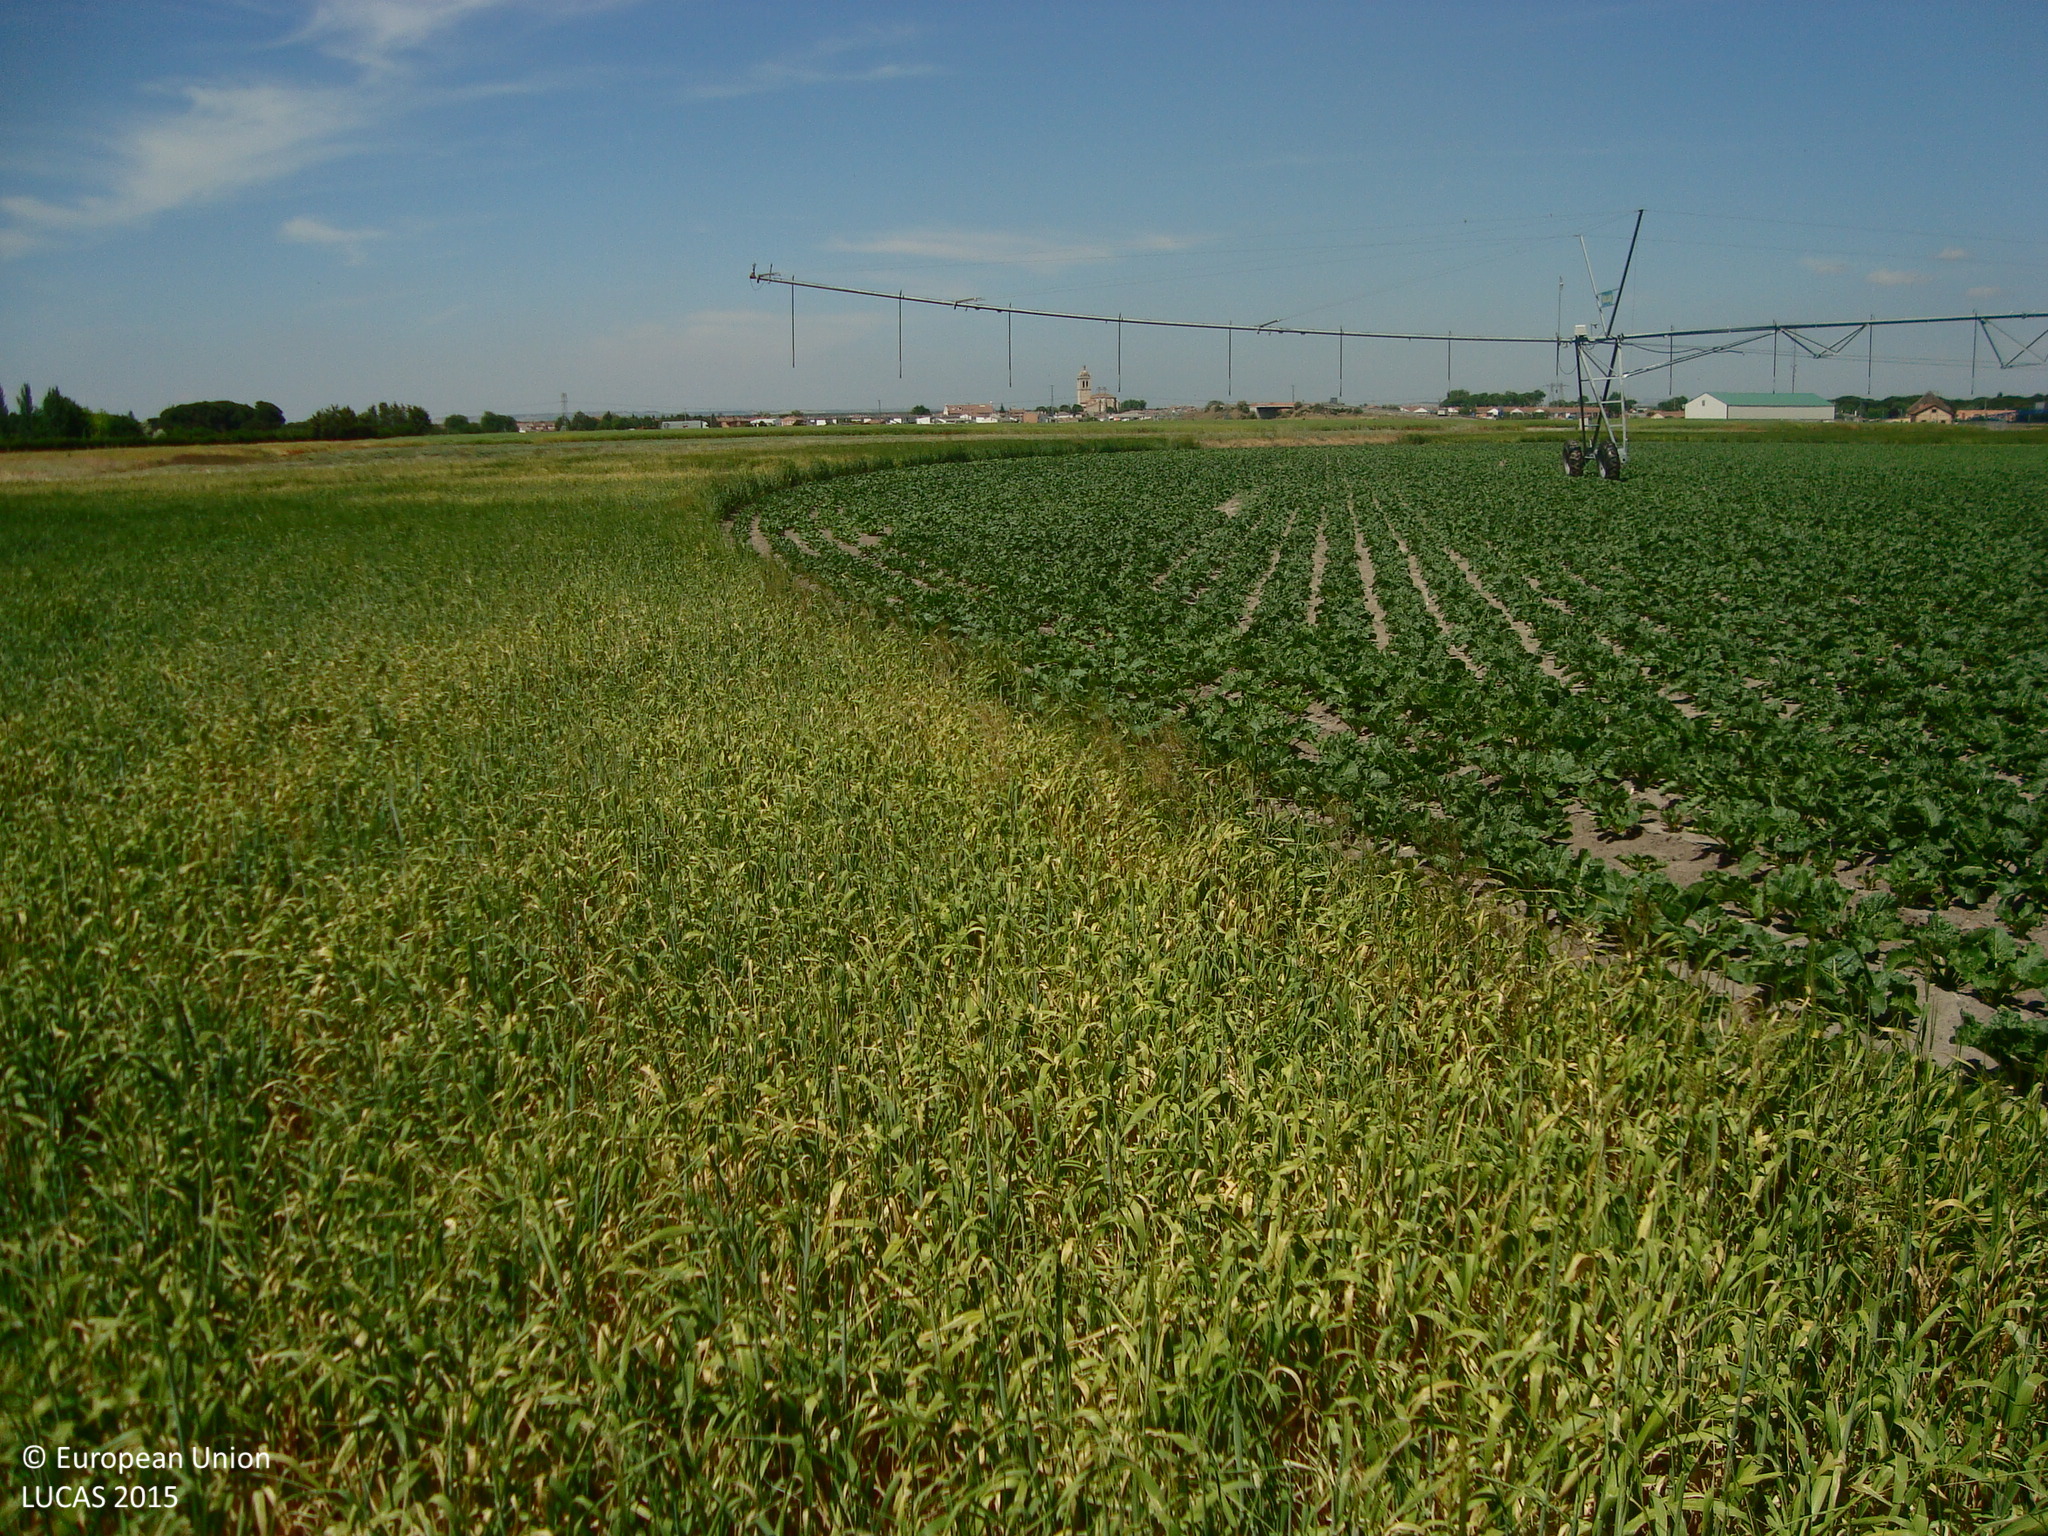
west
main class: Cropland
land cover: Barley
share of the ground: > 75 %
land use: Agriculture (excluding fallow land and kitchen gardens)
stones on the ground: < 10 %
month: June
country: ES
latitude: 41.5128
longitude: -4.6235
